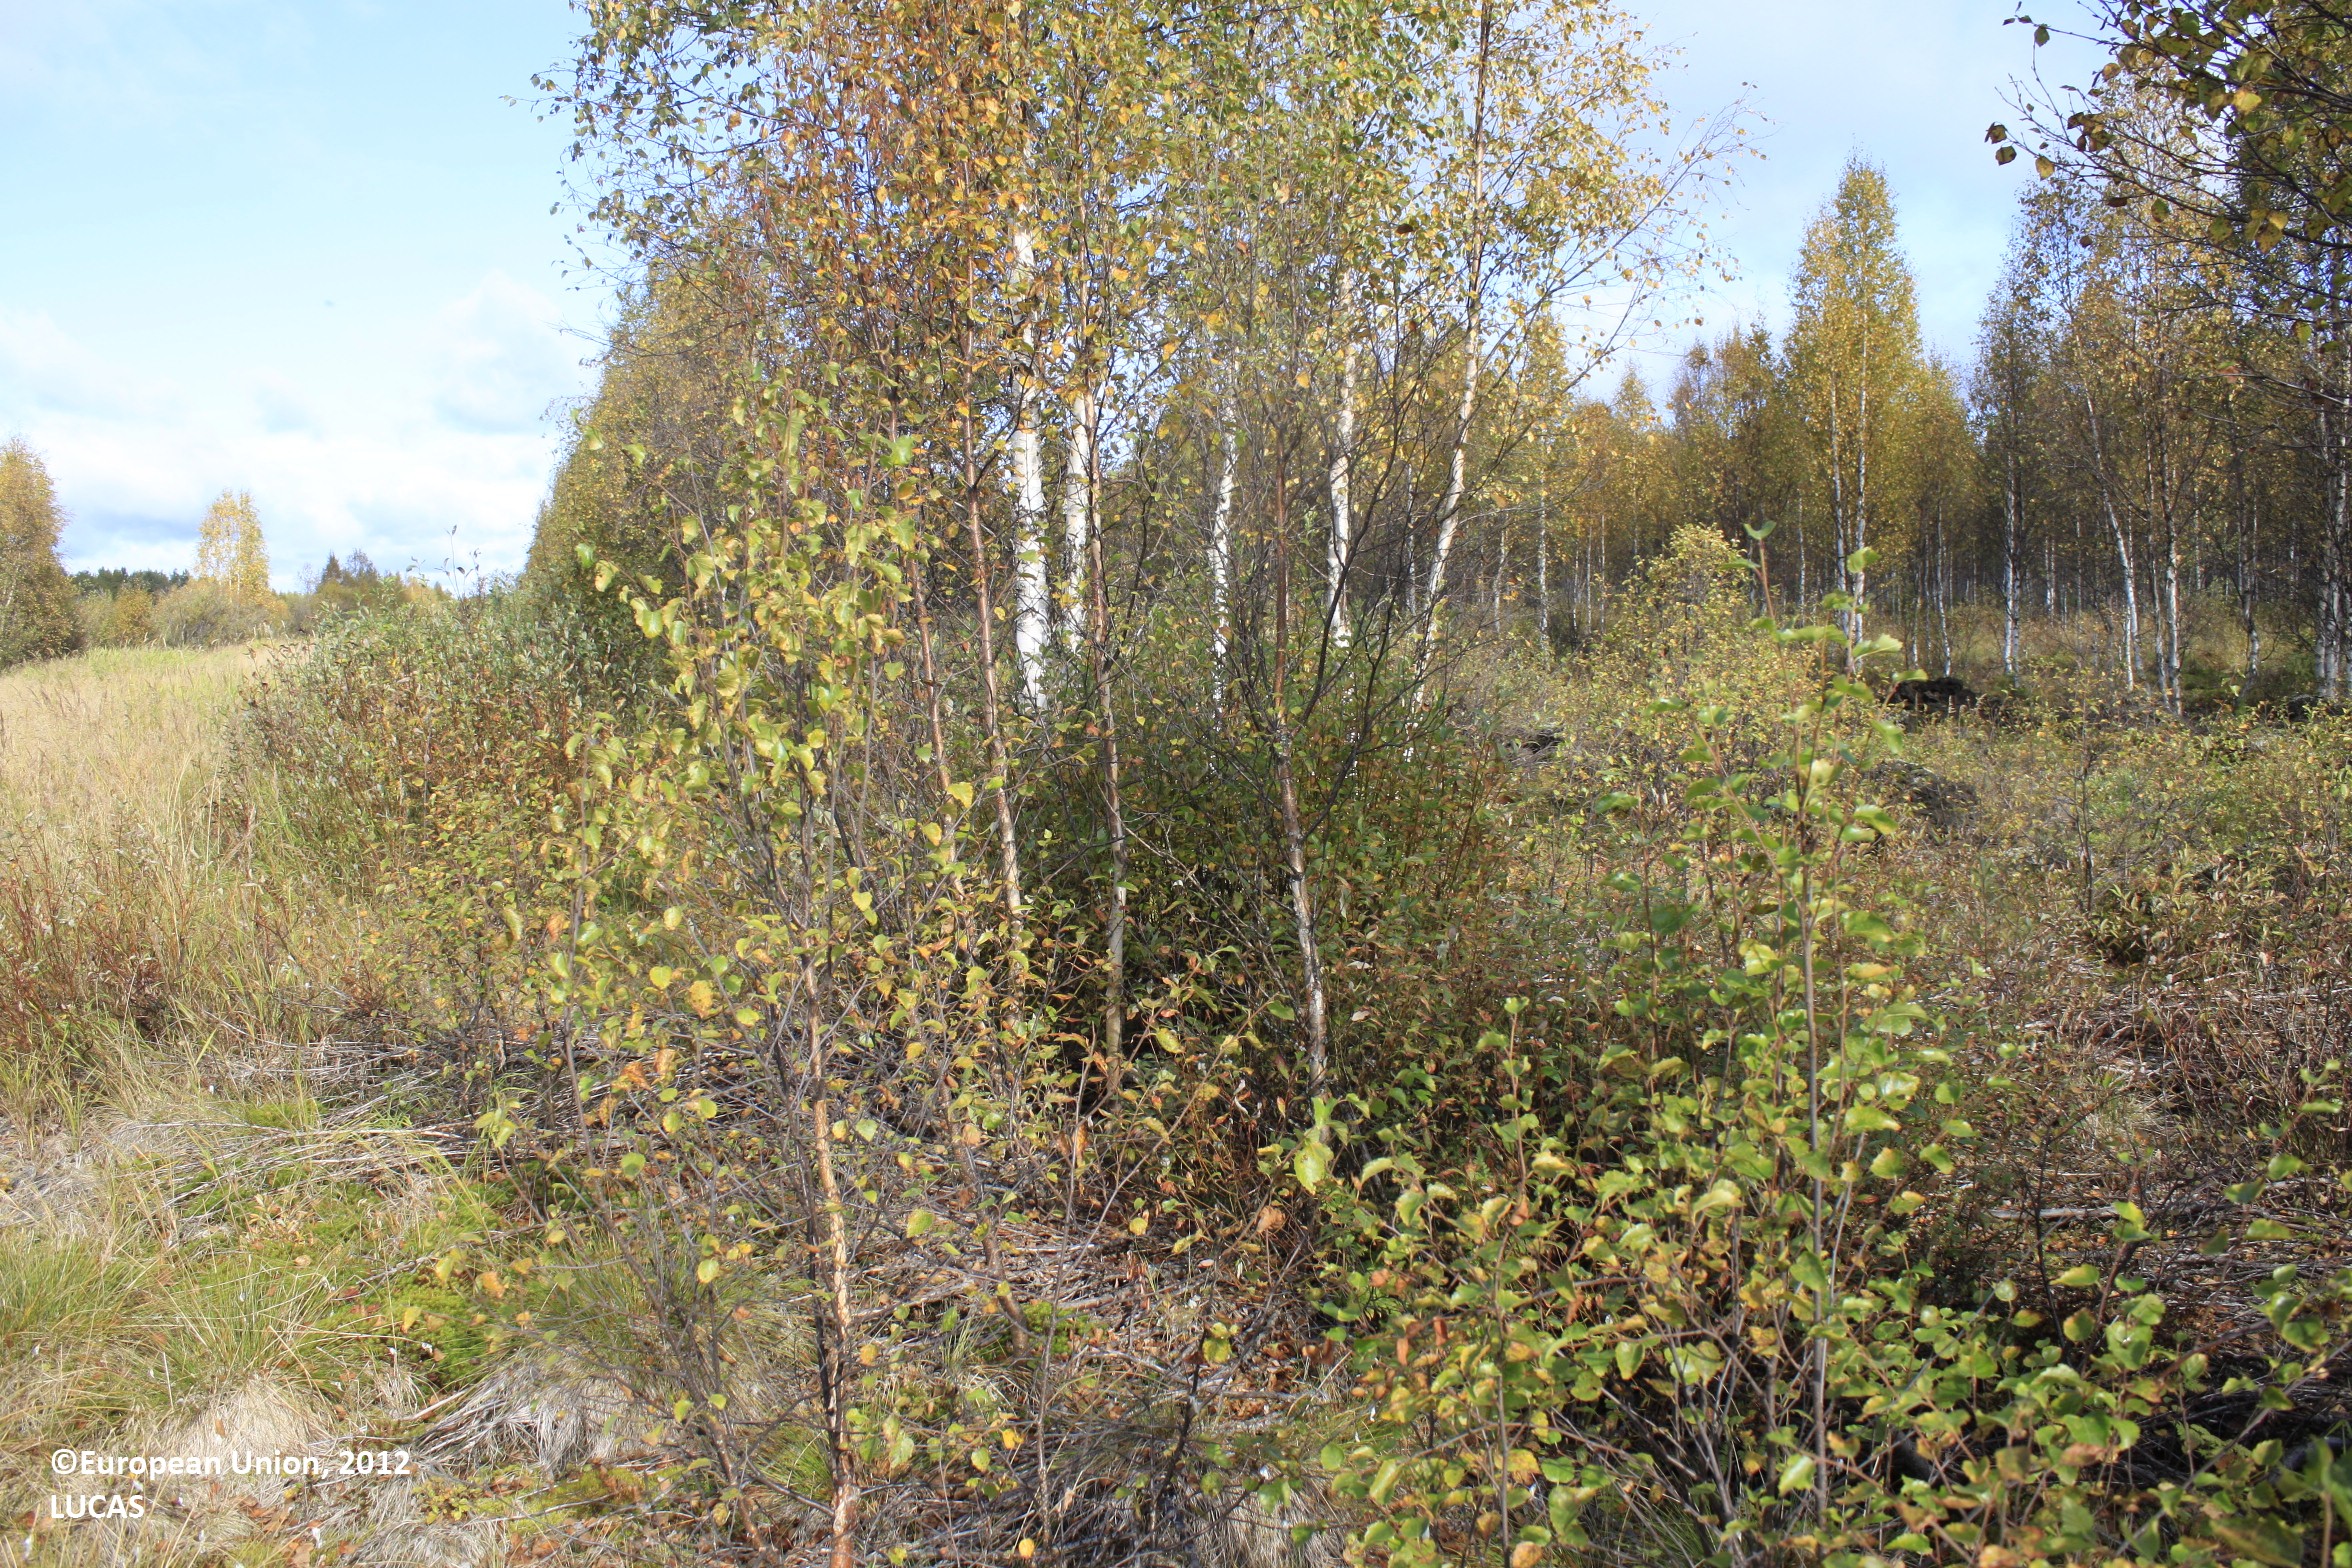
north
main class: Woodland
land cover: Broadleaved woodland
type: boreal forest
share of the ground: 25 - 50 %
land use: Forestry
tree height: < 5 m
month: September
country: FI
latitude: 65.6364
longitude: 26.5462
